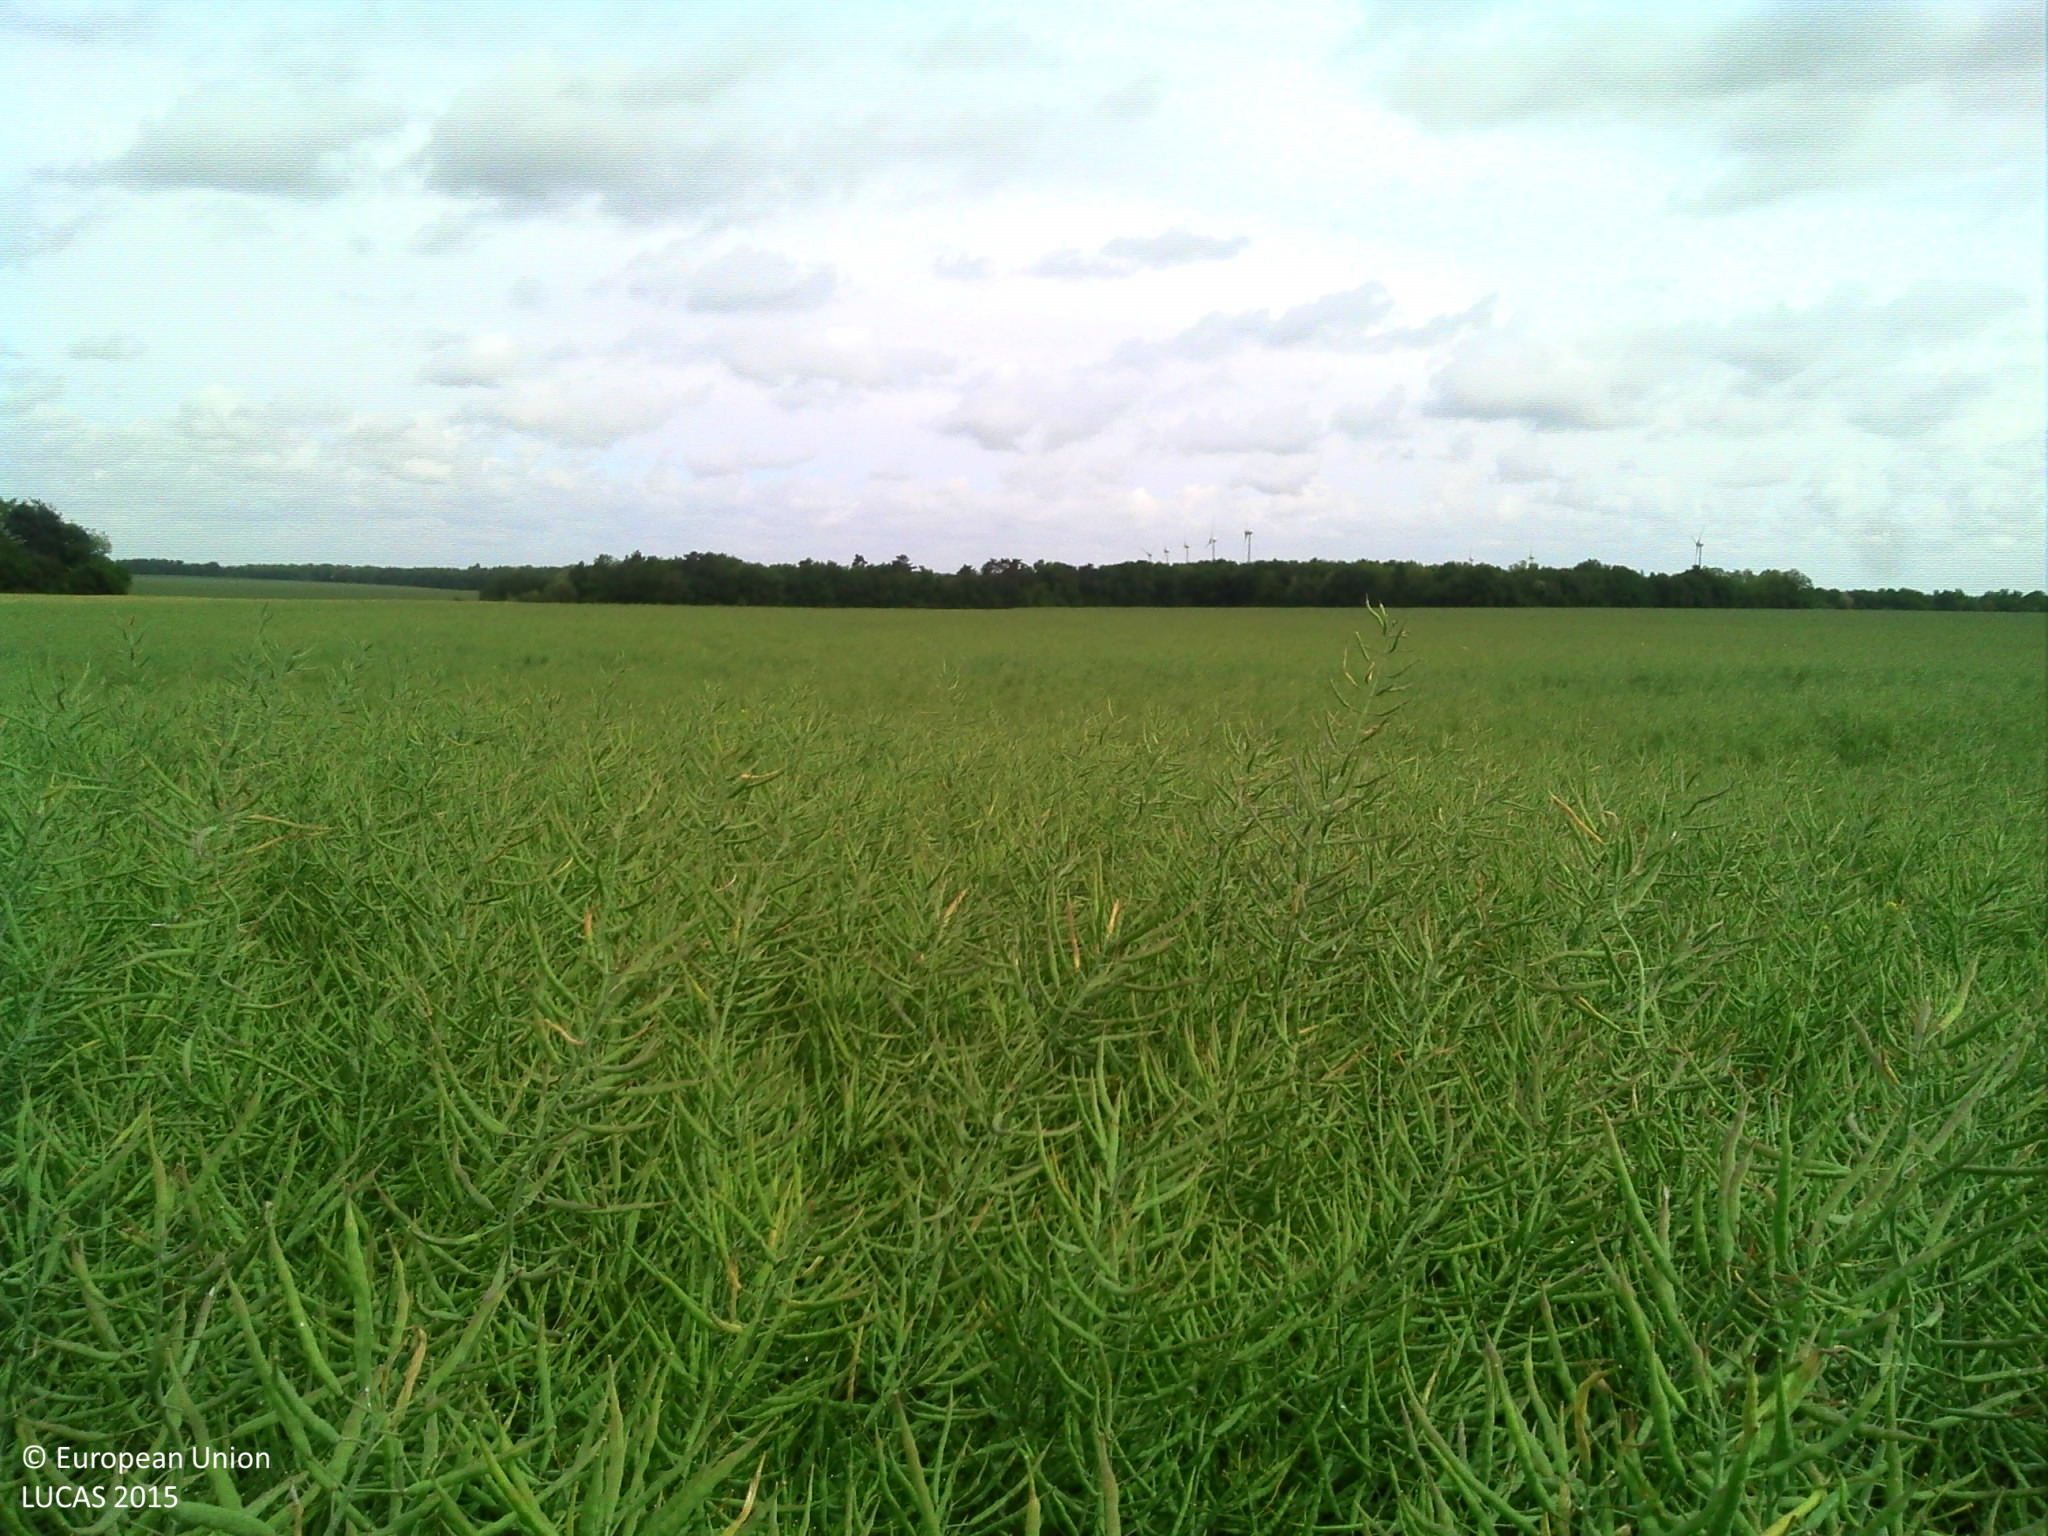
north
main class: Cropland
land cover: Rape and turnip rape
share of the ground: > 75 %
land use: Agriculture (excluding fallow land and kitchen gardens)
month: June
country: FR
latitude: 48.3453
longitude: 1.9584
